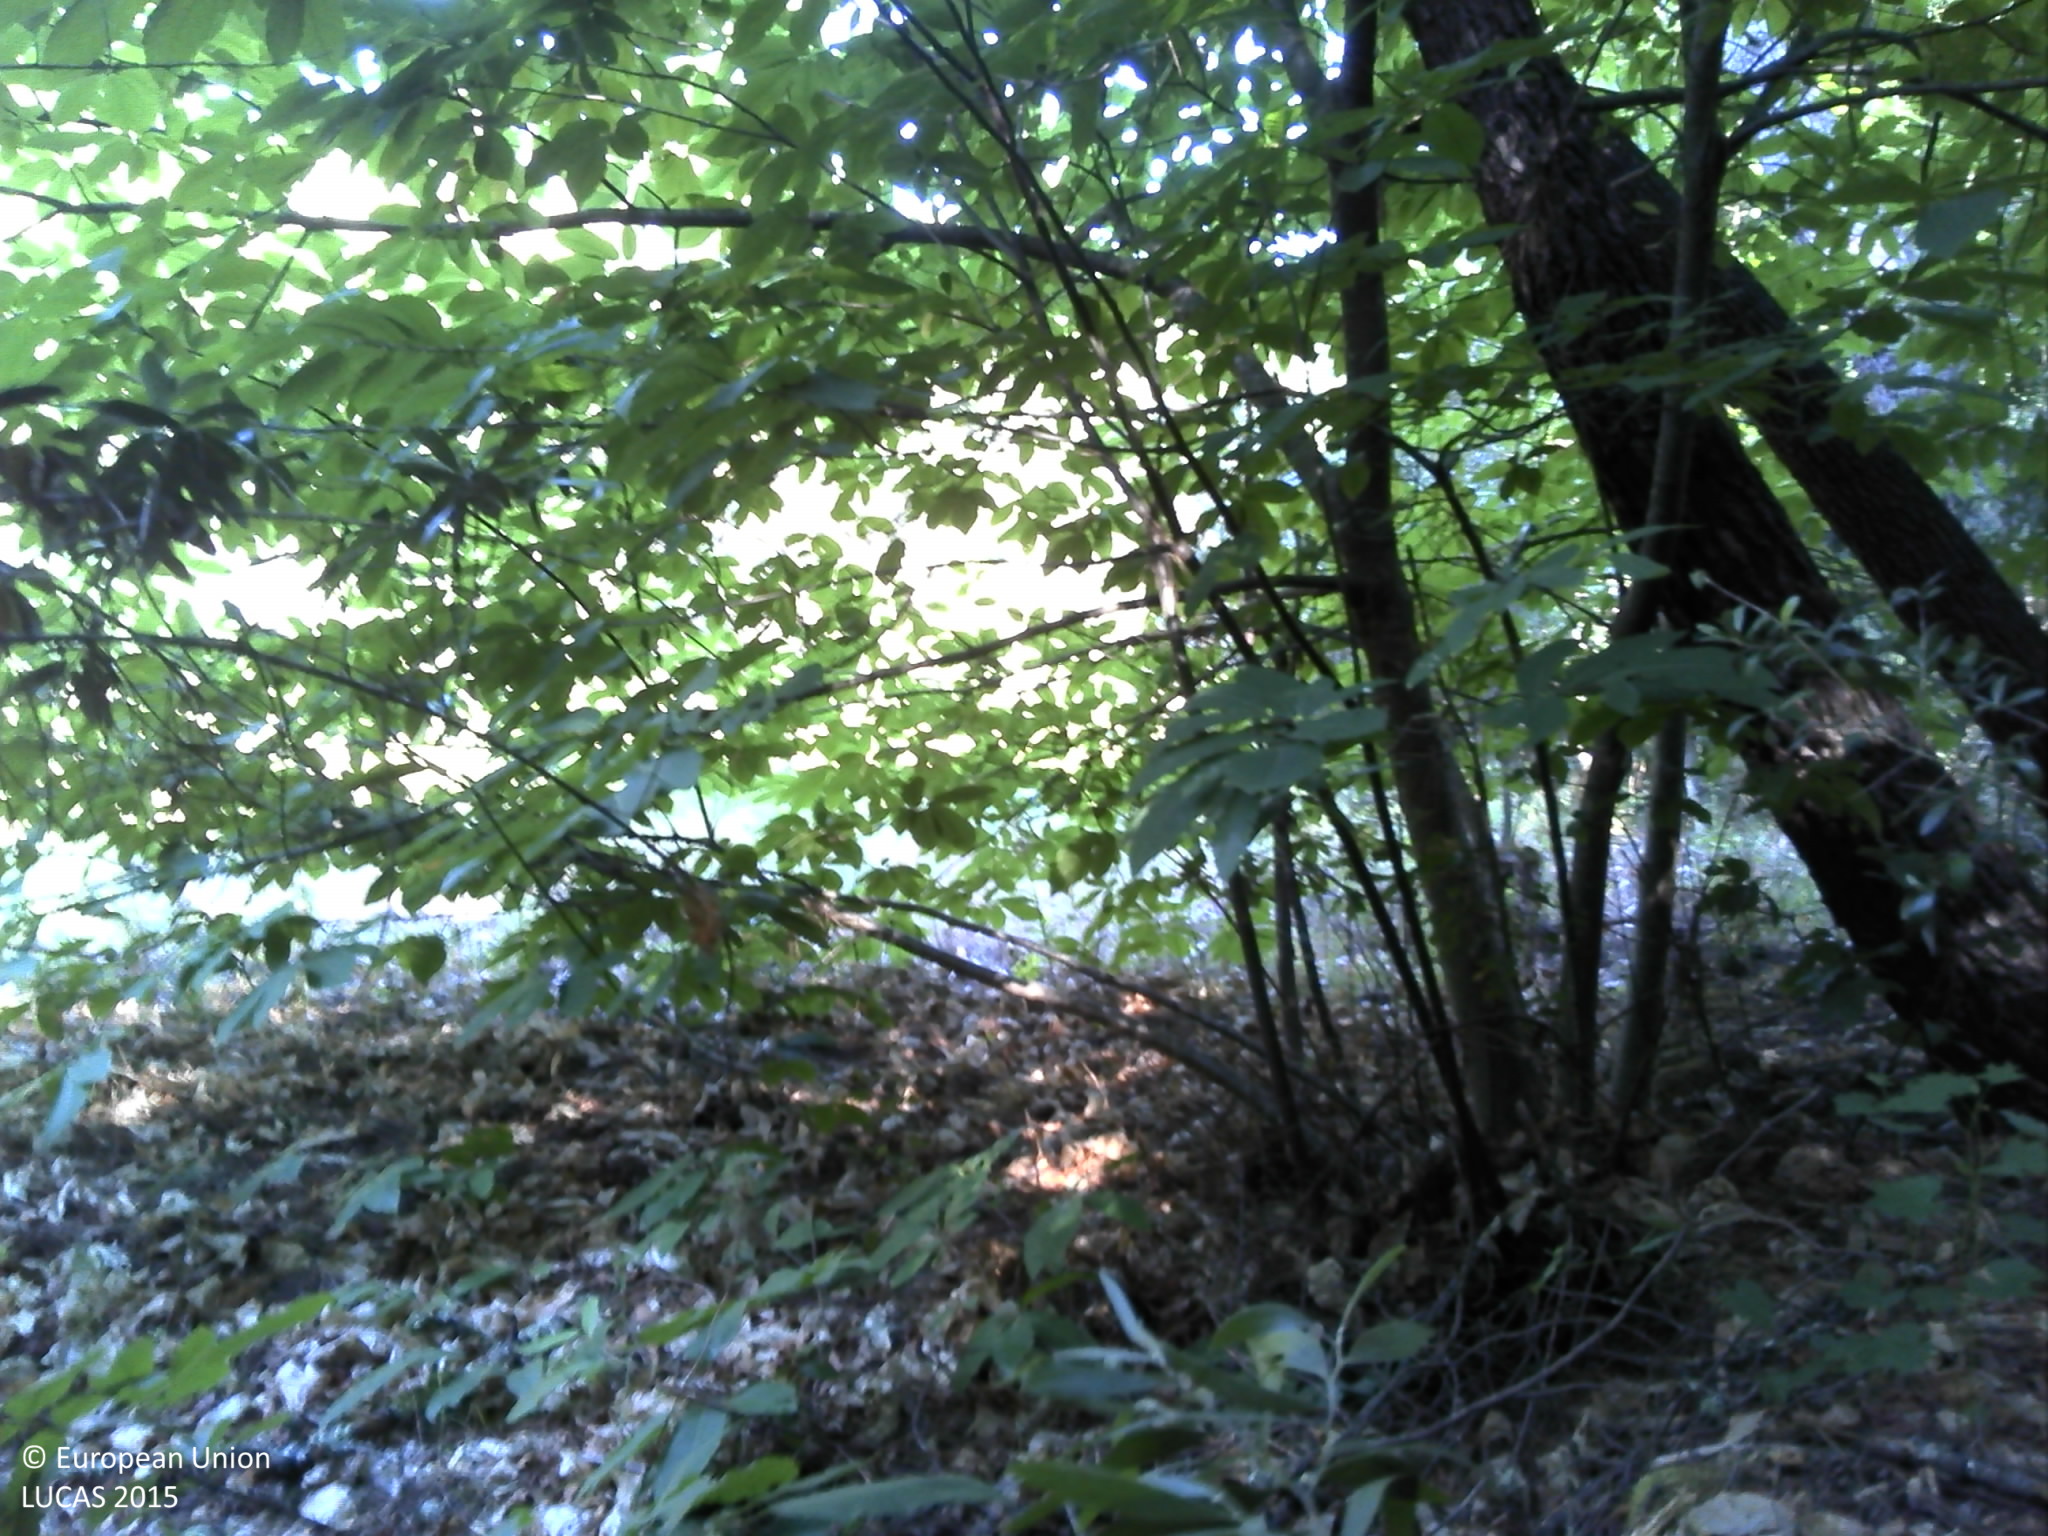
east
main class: Woodland
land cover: Broadleaved woodland
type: thermophilous deciduous forest
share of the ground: 10 - 25 %
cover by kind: broadleaved forest trees 75 %, unconsolidated bare surface 20 %, shrubs 5 %
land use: Forestry
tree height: > 5 m
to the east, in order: Broadleaved woodland; Olive groves; Broadleaved woodland; Tracks; Pine dominated mixed woodland; Pine dominated coniferous woodland; Dry stone walls; Tracks; Dry stone walls; Vineyards; Dry stone walls; Single bushes/trees; Vineyards; Olive groves; Dry stone walls; Spontaneously vegetated surfaces
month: July
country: PT
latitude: 40.7125
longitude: -7.7951
